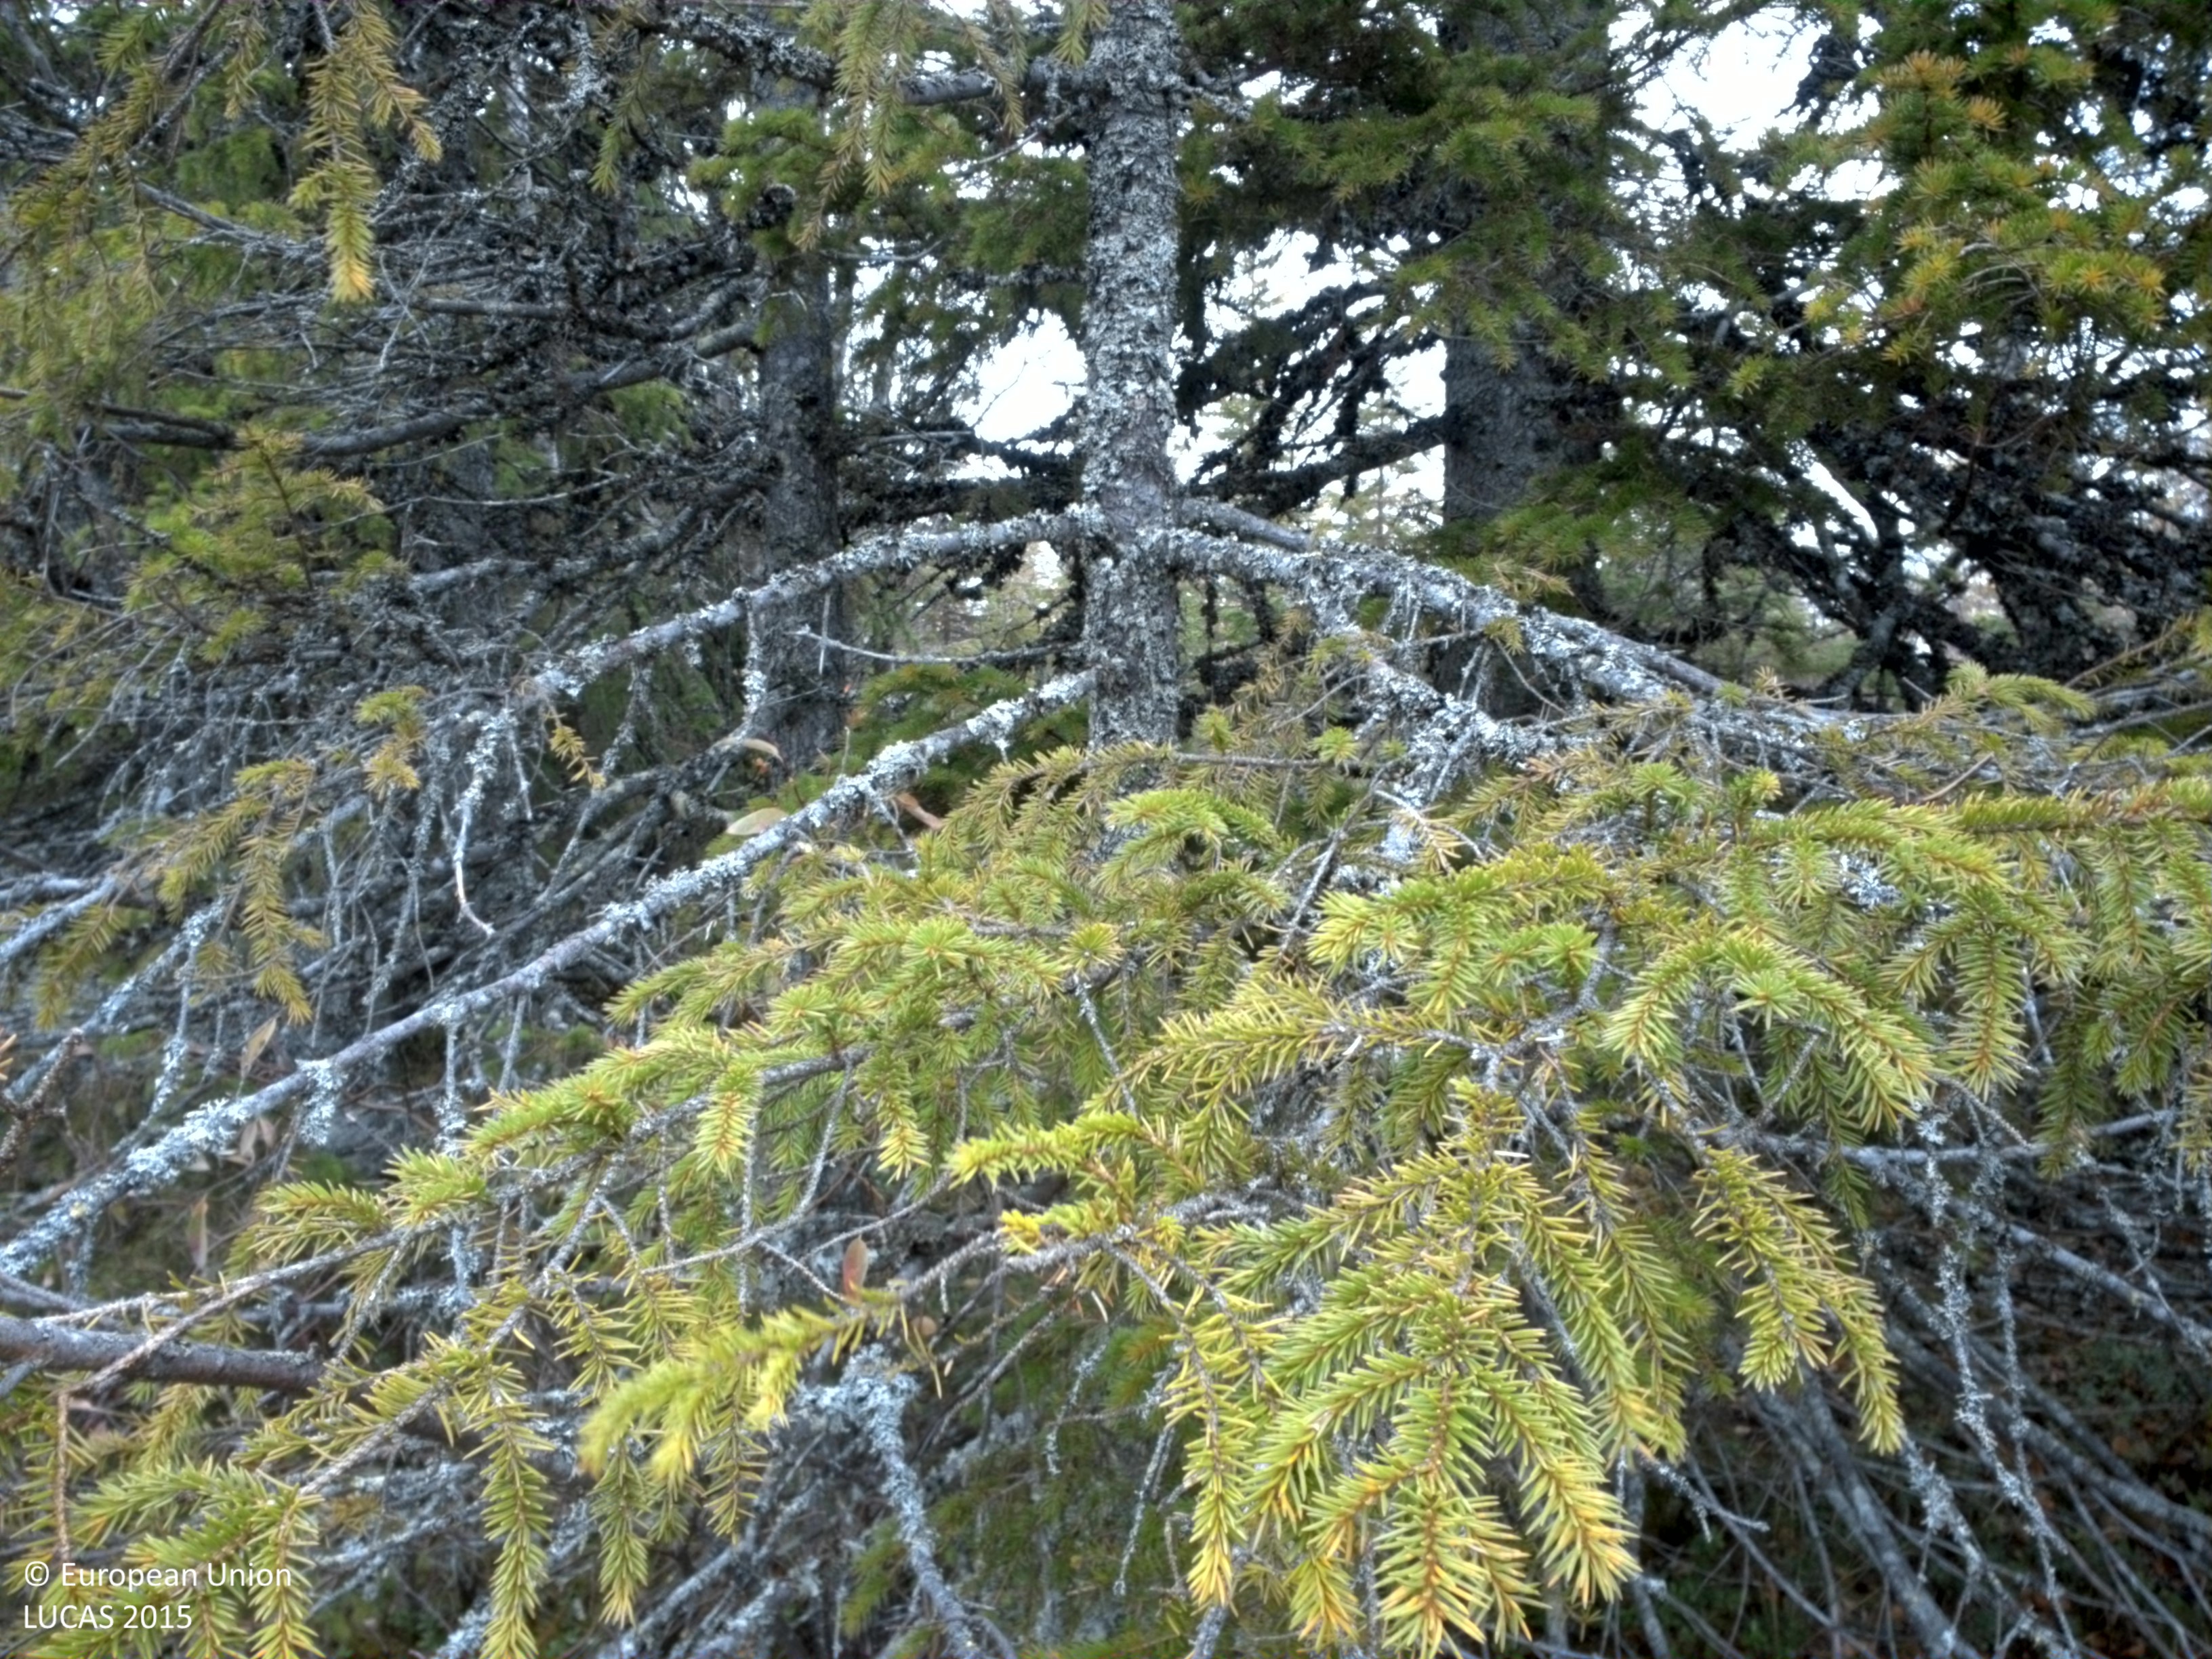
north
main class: Woodland
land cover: Spruce dominated mixed woodland
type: boreal forest
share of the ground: 25 - 50 %
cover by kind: shrubs 40 %, coniferous forest trees 20 %, broadleaved forest trees 20 %, herbaceous plants 10 %, lichens and mosses 10 %
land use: Forestry
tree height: > 5 m
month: October
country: SE
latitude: 64.8842
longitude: 16.8696
